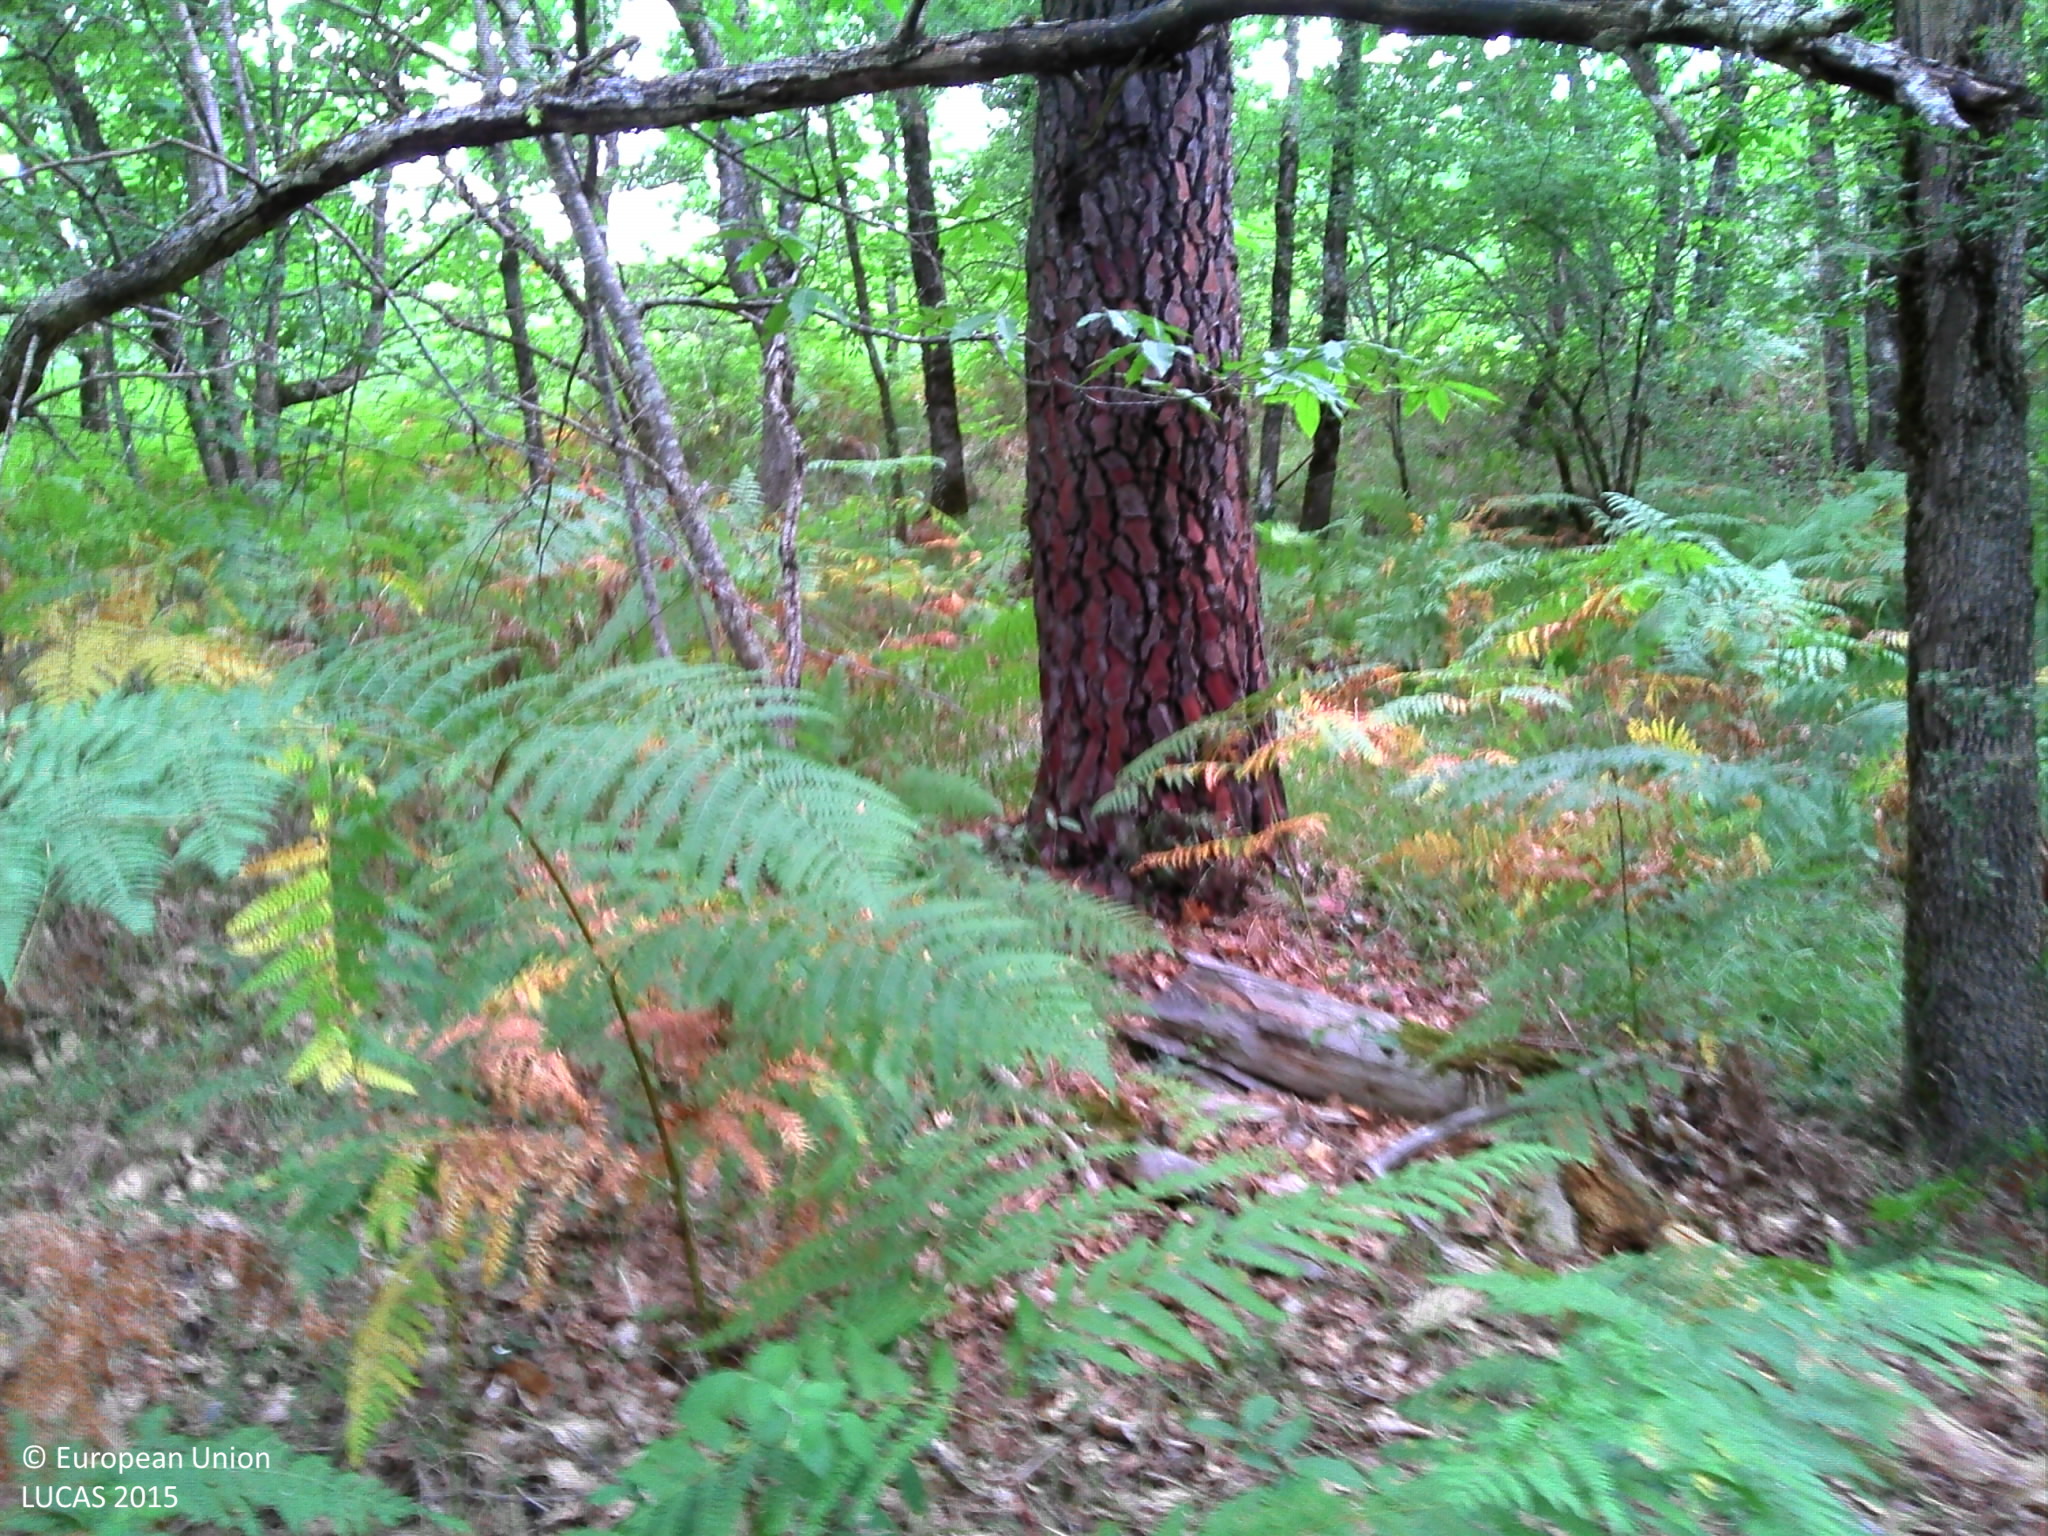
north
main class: Woodland
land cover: Broadleaved woodland
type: thermophilous deciduous forest
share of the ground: > 75 %
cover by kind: broadleaved forest trees 75 %, shrubs 10 %, herbaceous plants 10 %, lichens and mosses 5 %
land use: Forestry
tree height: > 5 m
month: July
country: FR
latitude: 45.0569
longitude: 1.1172
